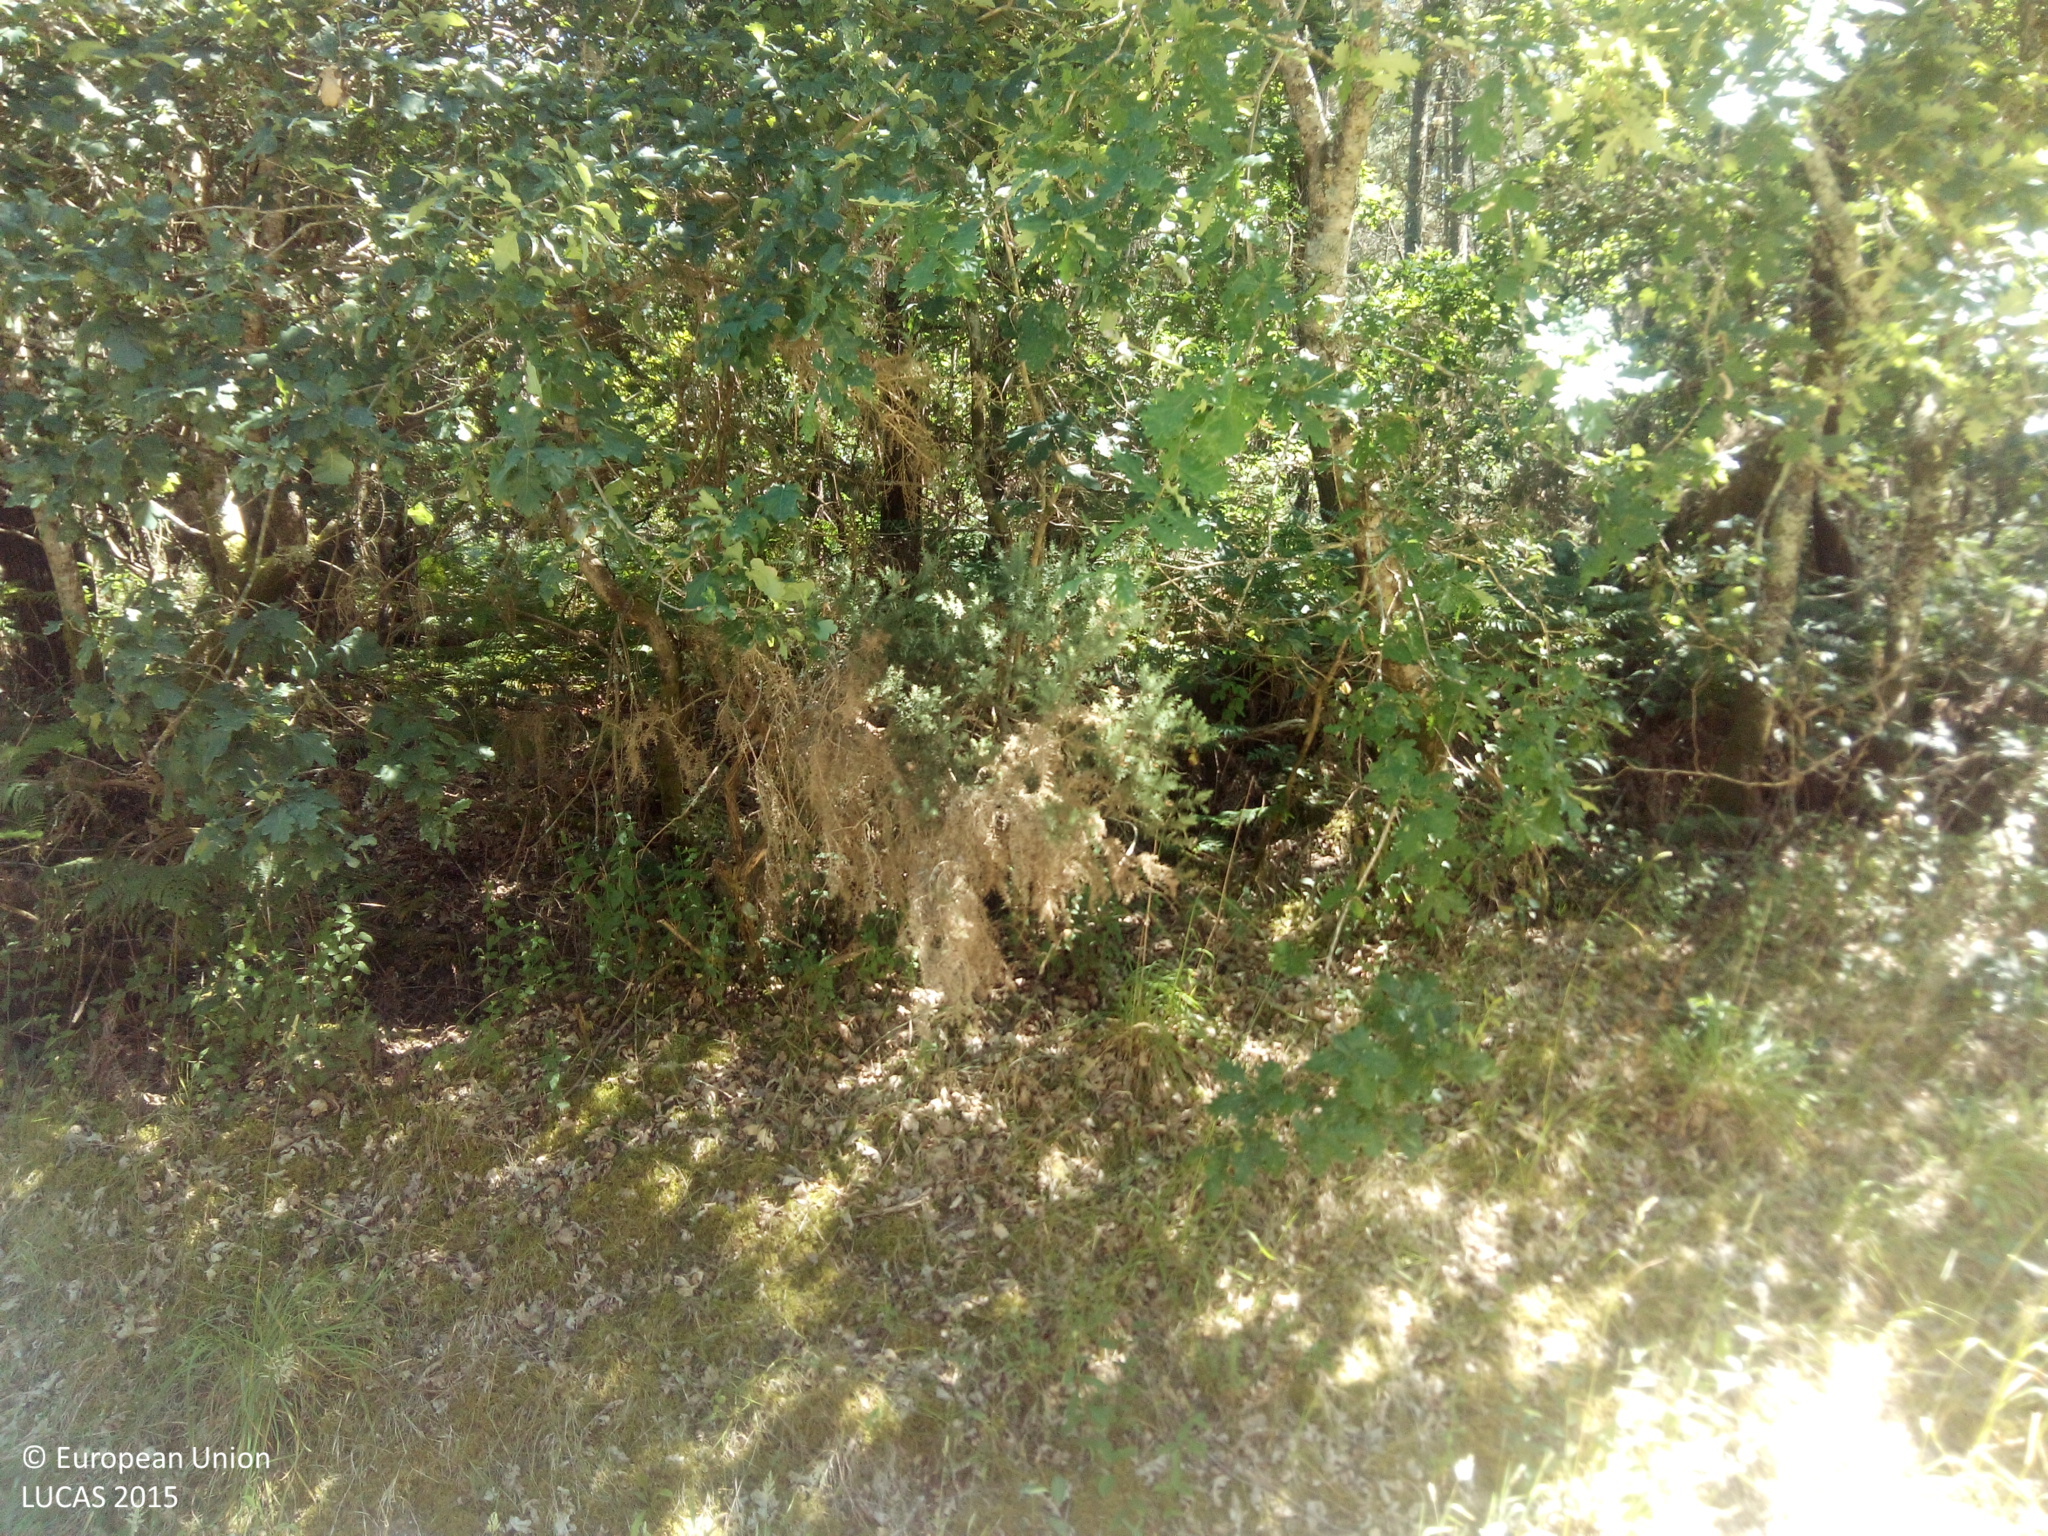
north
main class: Woodland
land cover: Pine dominated mixed woodland
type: hemiboreal forest and nemoral coniferous forest and mixed broadleaved-coniferous forest
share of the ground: > 75 %
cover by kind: coniferous forest trees 75 %, broadleaved forest trees 25 %
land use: Forestry
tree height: > 5 m
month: June
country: ES
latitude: 42.7586
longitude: -8.4154
